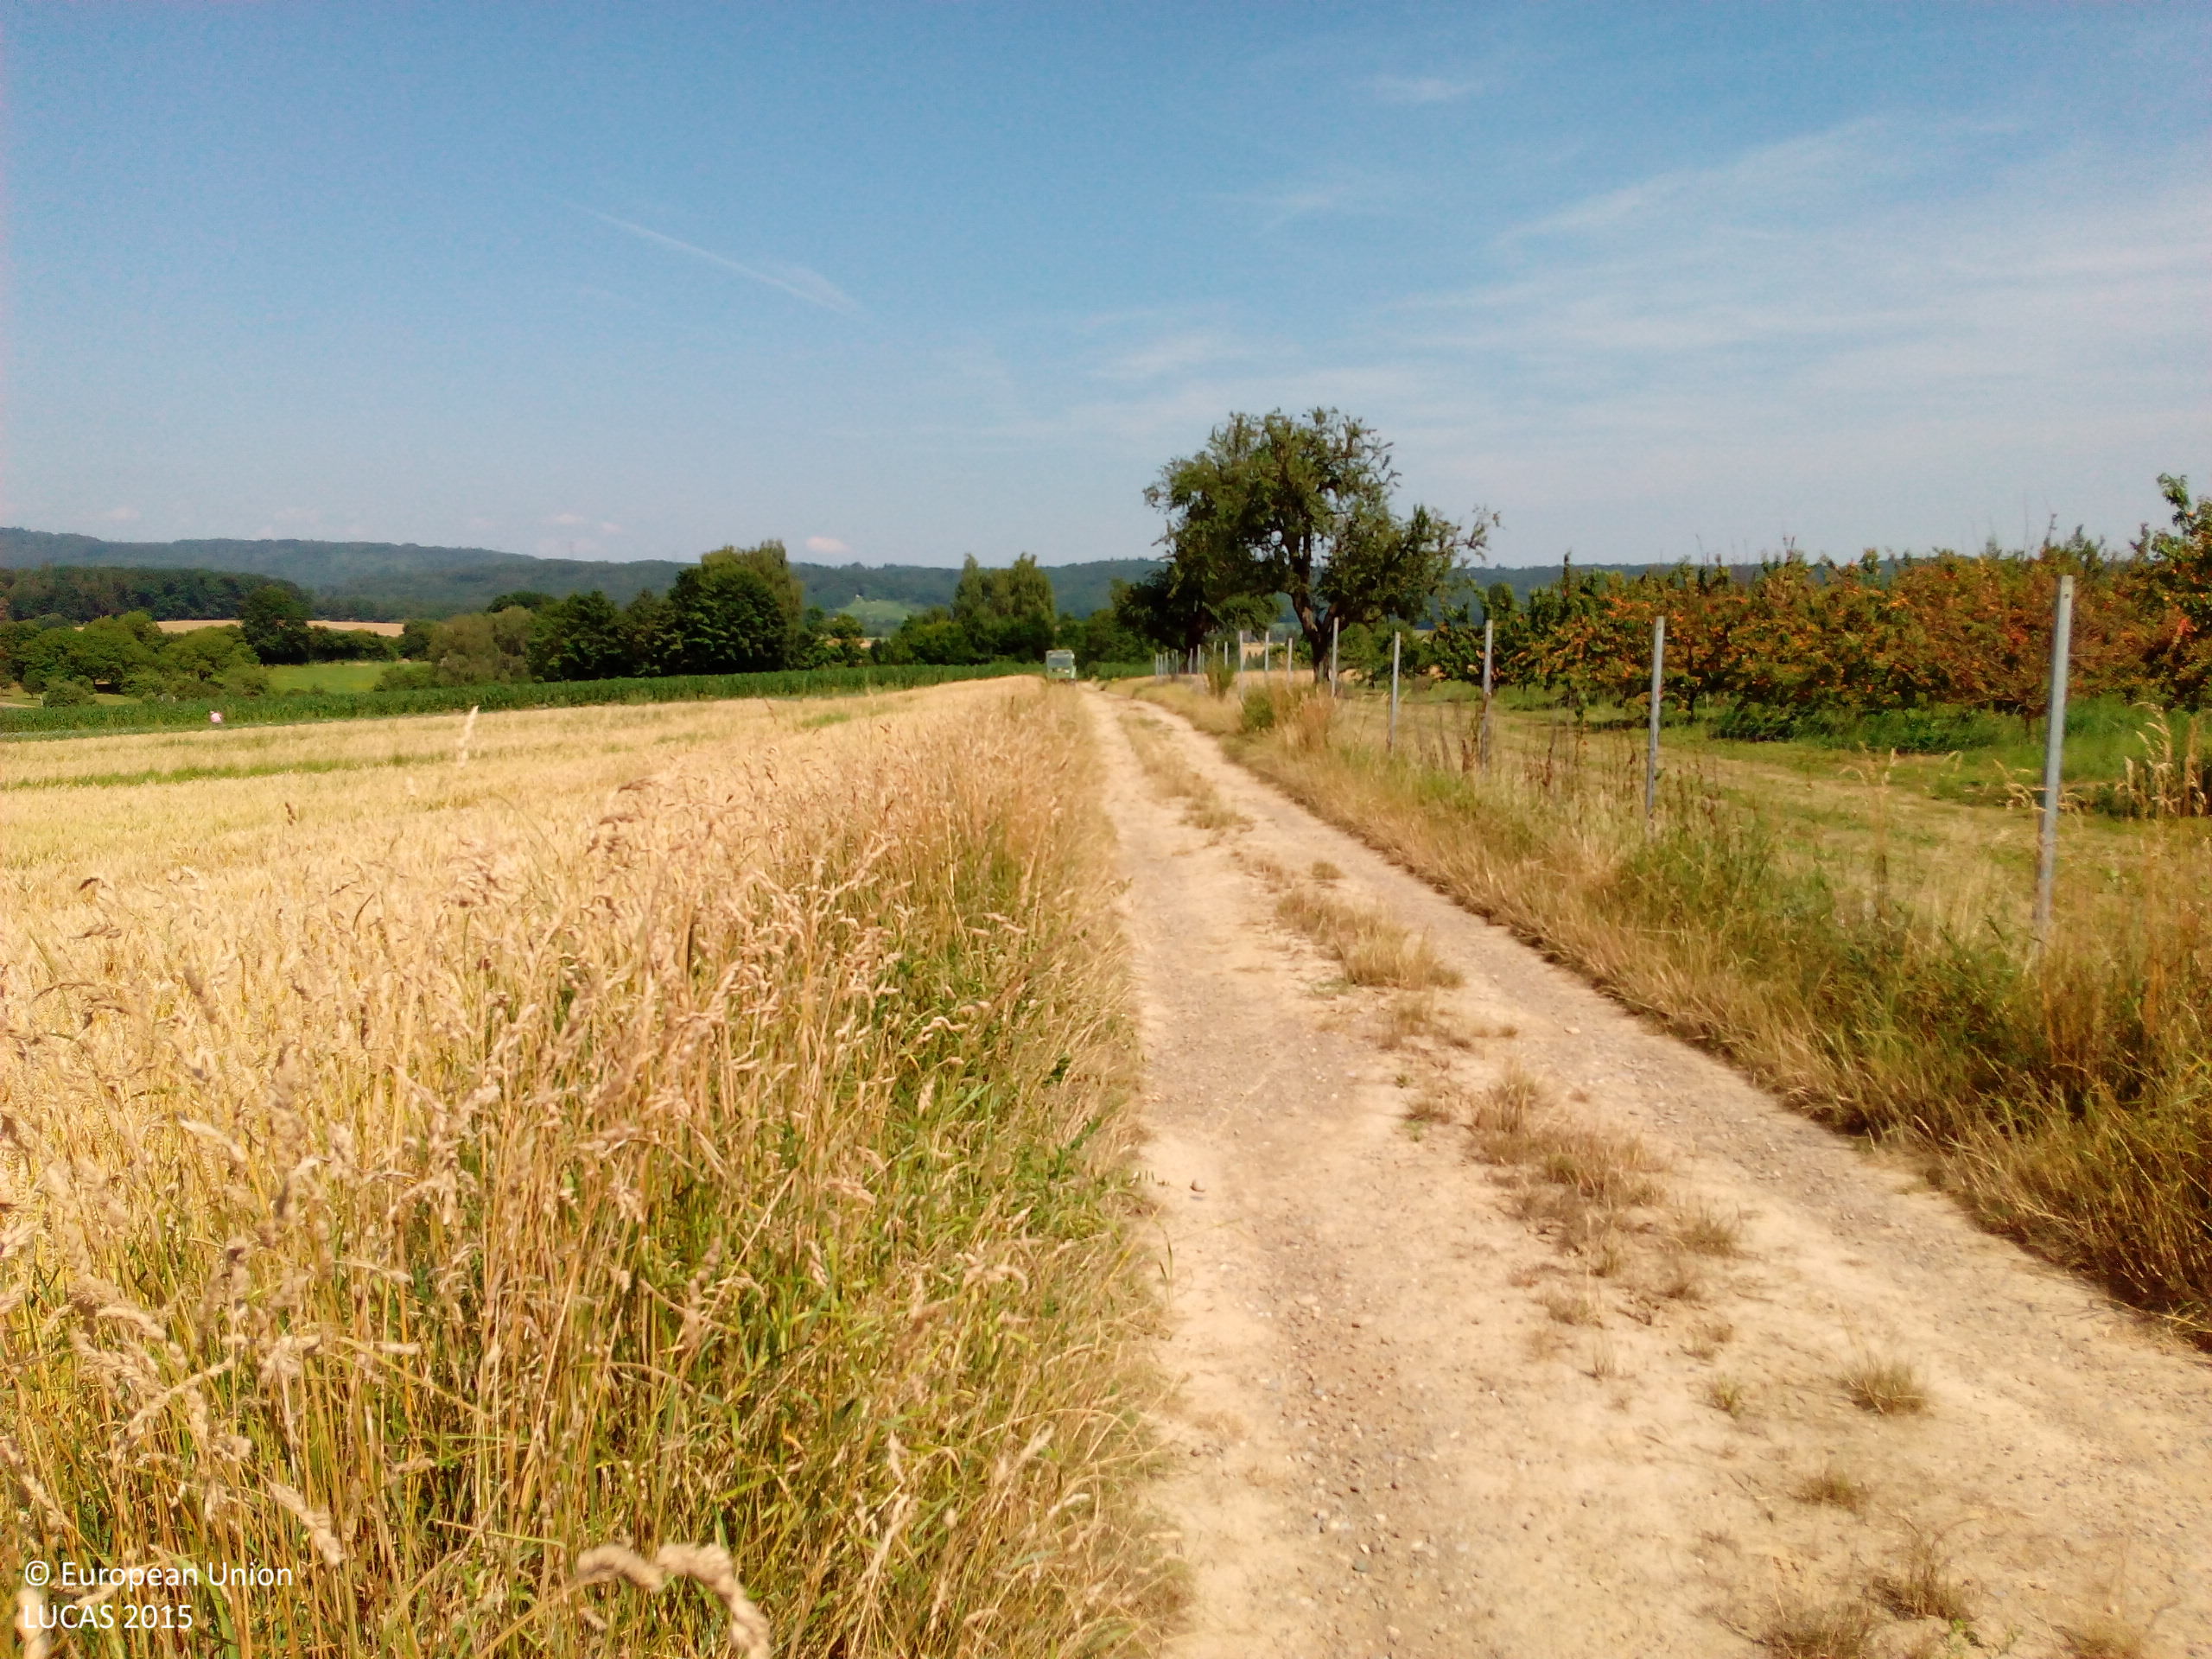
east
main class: Cropland
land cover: Common wheat
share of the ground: > 75 %
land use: Agriculture (excluding fallow land and kitchen gardens)
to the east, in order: Common wheat; Grass margins; Other bare soil; Potatoes; Other fresh vegetables; Other bare soil; Other root crops; Other fresh vegetables; Maize; Tracks; Broadleaved woodland; Paved roads, cycling and walking lanes; Grassland without tree/shrub cover; Ditches and canals; Broadleaved woodland; Tracks
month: July
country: DE
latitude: 47.6577
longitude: 7.6181
